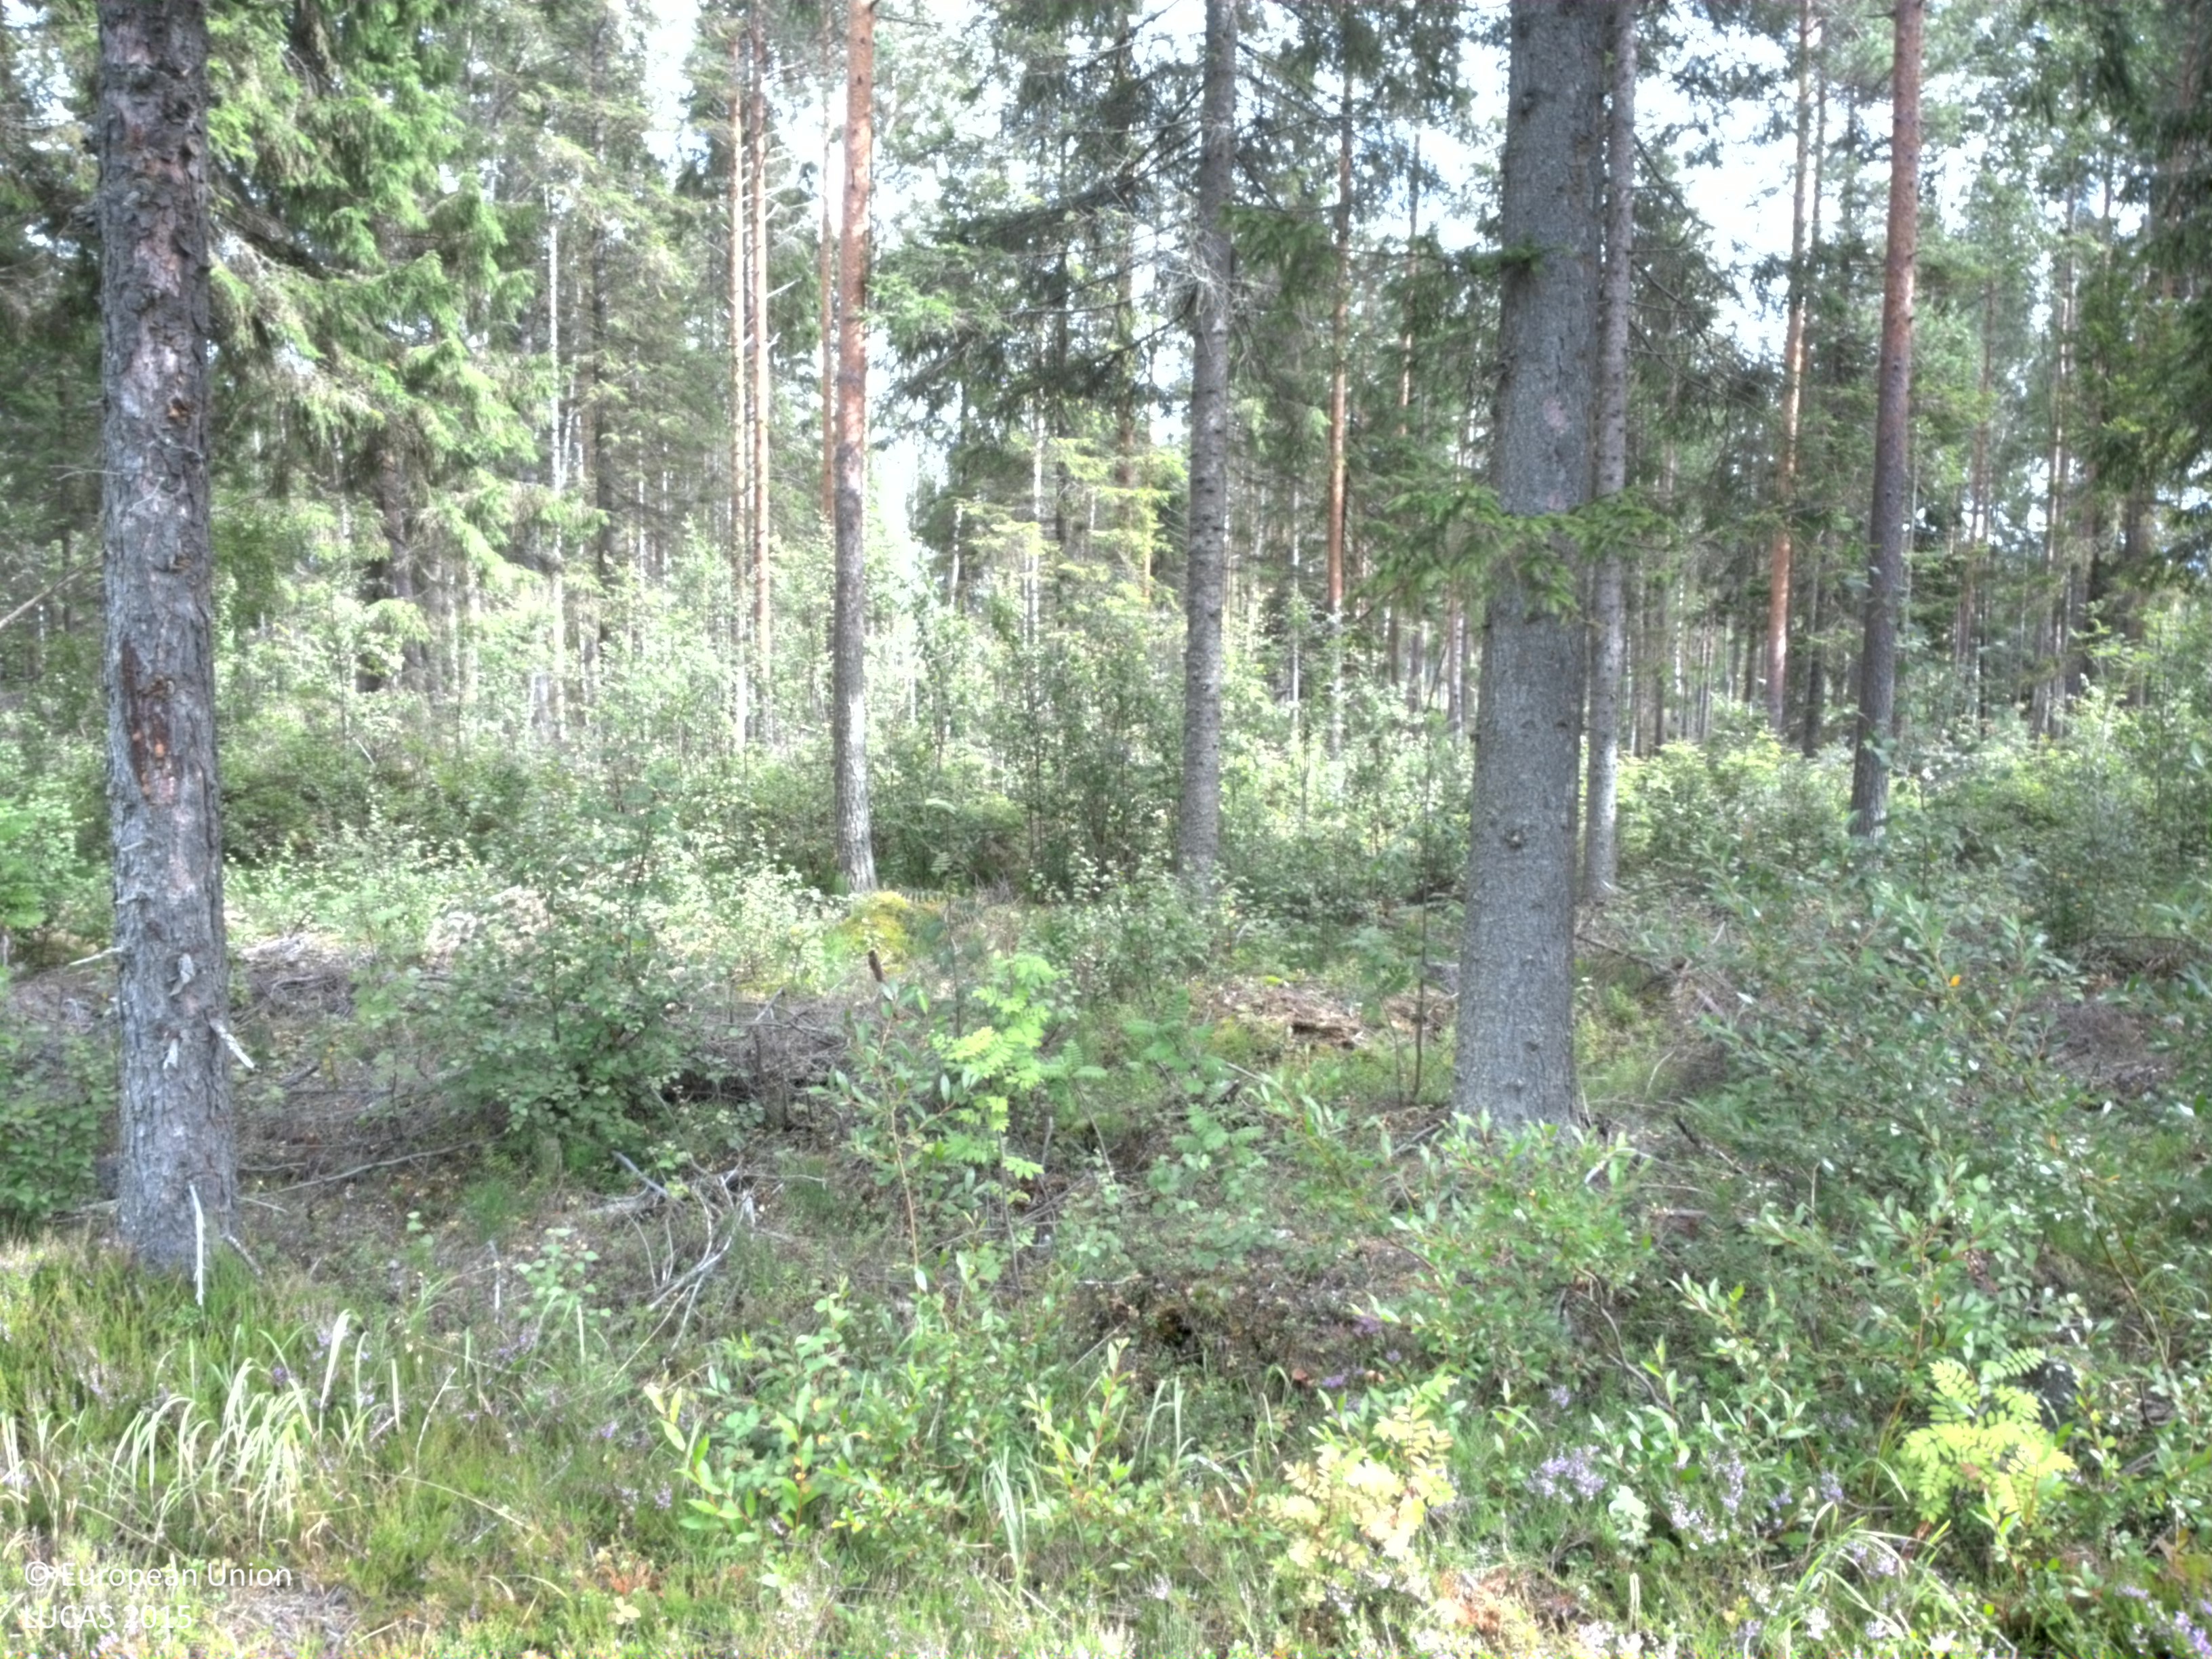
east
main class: Woodland
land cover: Spruce dominated mixed woodland
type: boreal forest
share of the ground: 50 - 75 %
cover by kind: coniferous forest trees 45 %, shrubs 25 %, broadleaved forest trees 15 %, herbaceous plants 10 %, lichens and mosses 5 %
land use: Forestry
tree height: > 5 m
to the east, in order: Grass margins; Ditches and canals; Spruce dominated mixed woodland; Ditches and canals; Shrubland with sparse tree cover; Broadleaved woodland
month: August
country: SE
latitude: 64.6207
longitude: 20.9575
